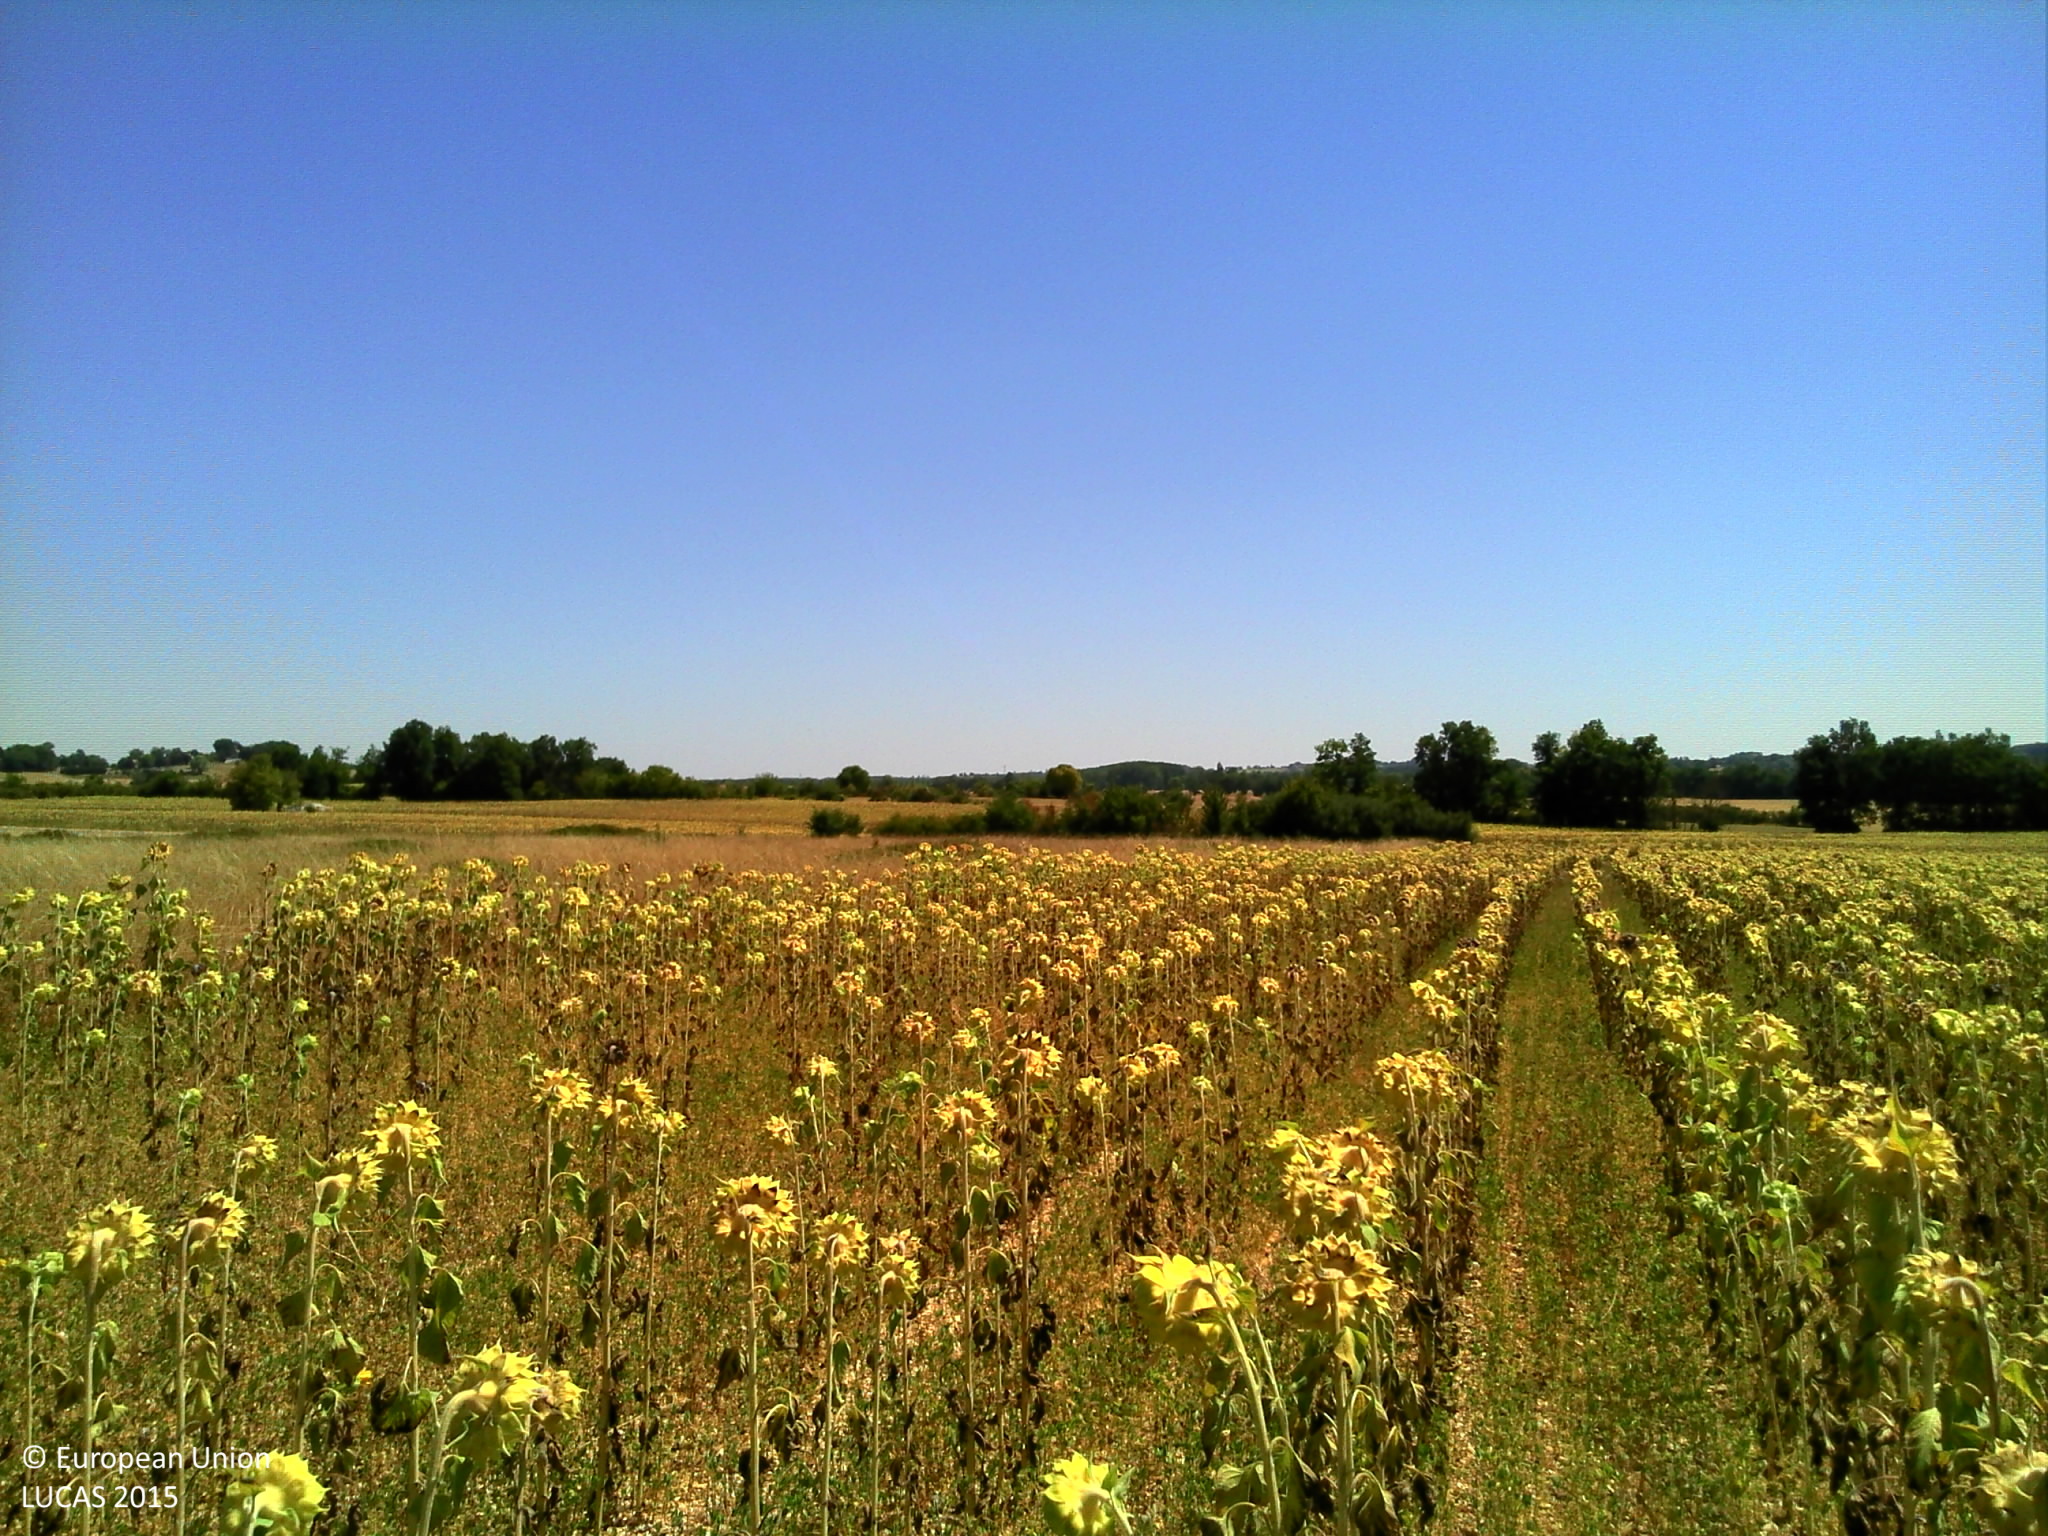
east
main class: Cropland
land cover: Sunflower
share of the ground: 25 - 50 %
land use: Agriculture (excluding fallow land and kitchen gardens)
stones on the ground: > 50 %
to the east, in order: Sunflower; Grassland without tree/shrub cover; Managed hedges; Sunflower
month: August
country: FR
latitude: 44.7403
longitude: 0.6083
